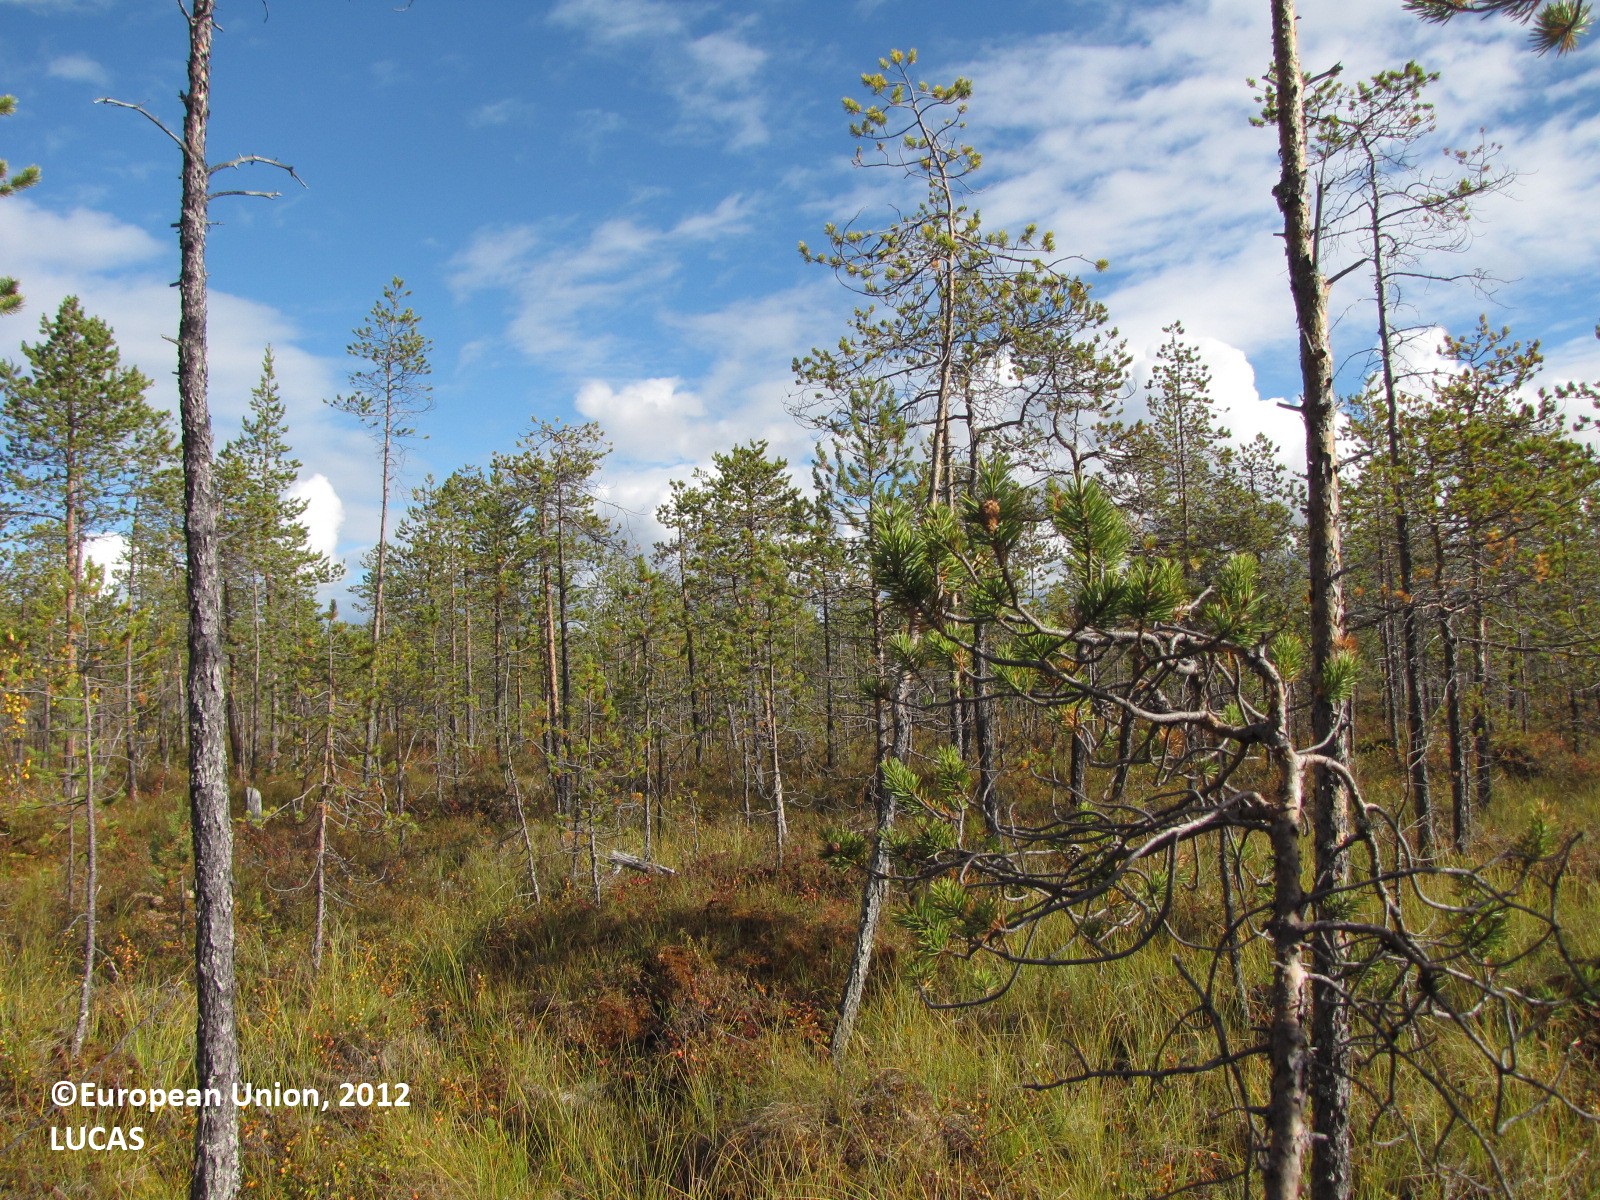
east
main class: Woodland
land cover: Pine dominated coniferous woodland
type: boreal forest
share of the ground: 25 - 50 %
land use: Forestry
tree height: > 5 m
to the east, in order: Pine dominated coniferous woodland; Grassland with sparse tree/shrub cover
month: September
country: FI
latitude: 67.3882
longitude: 24.8854
